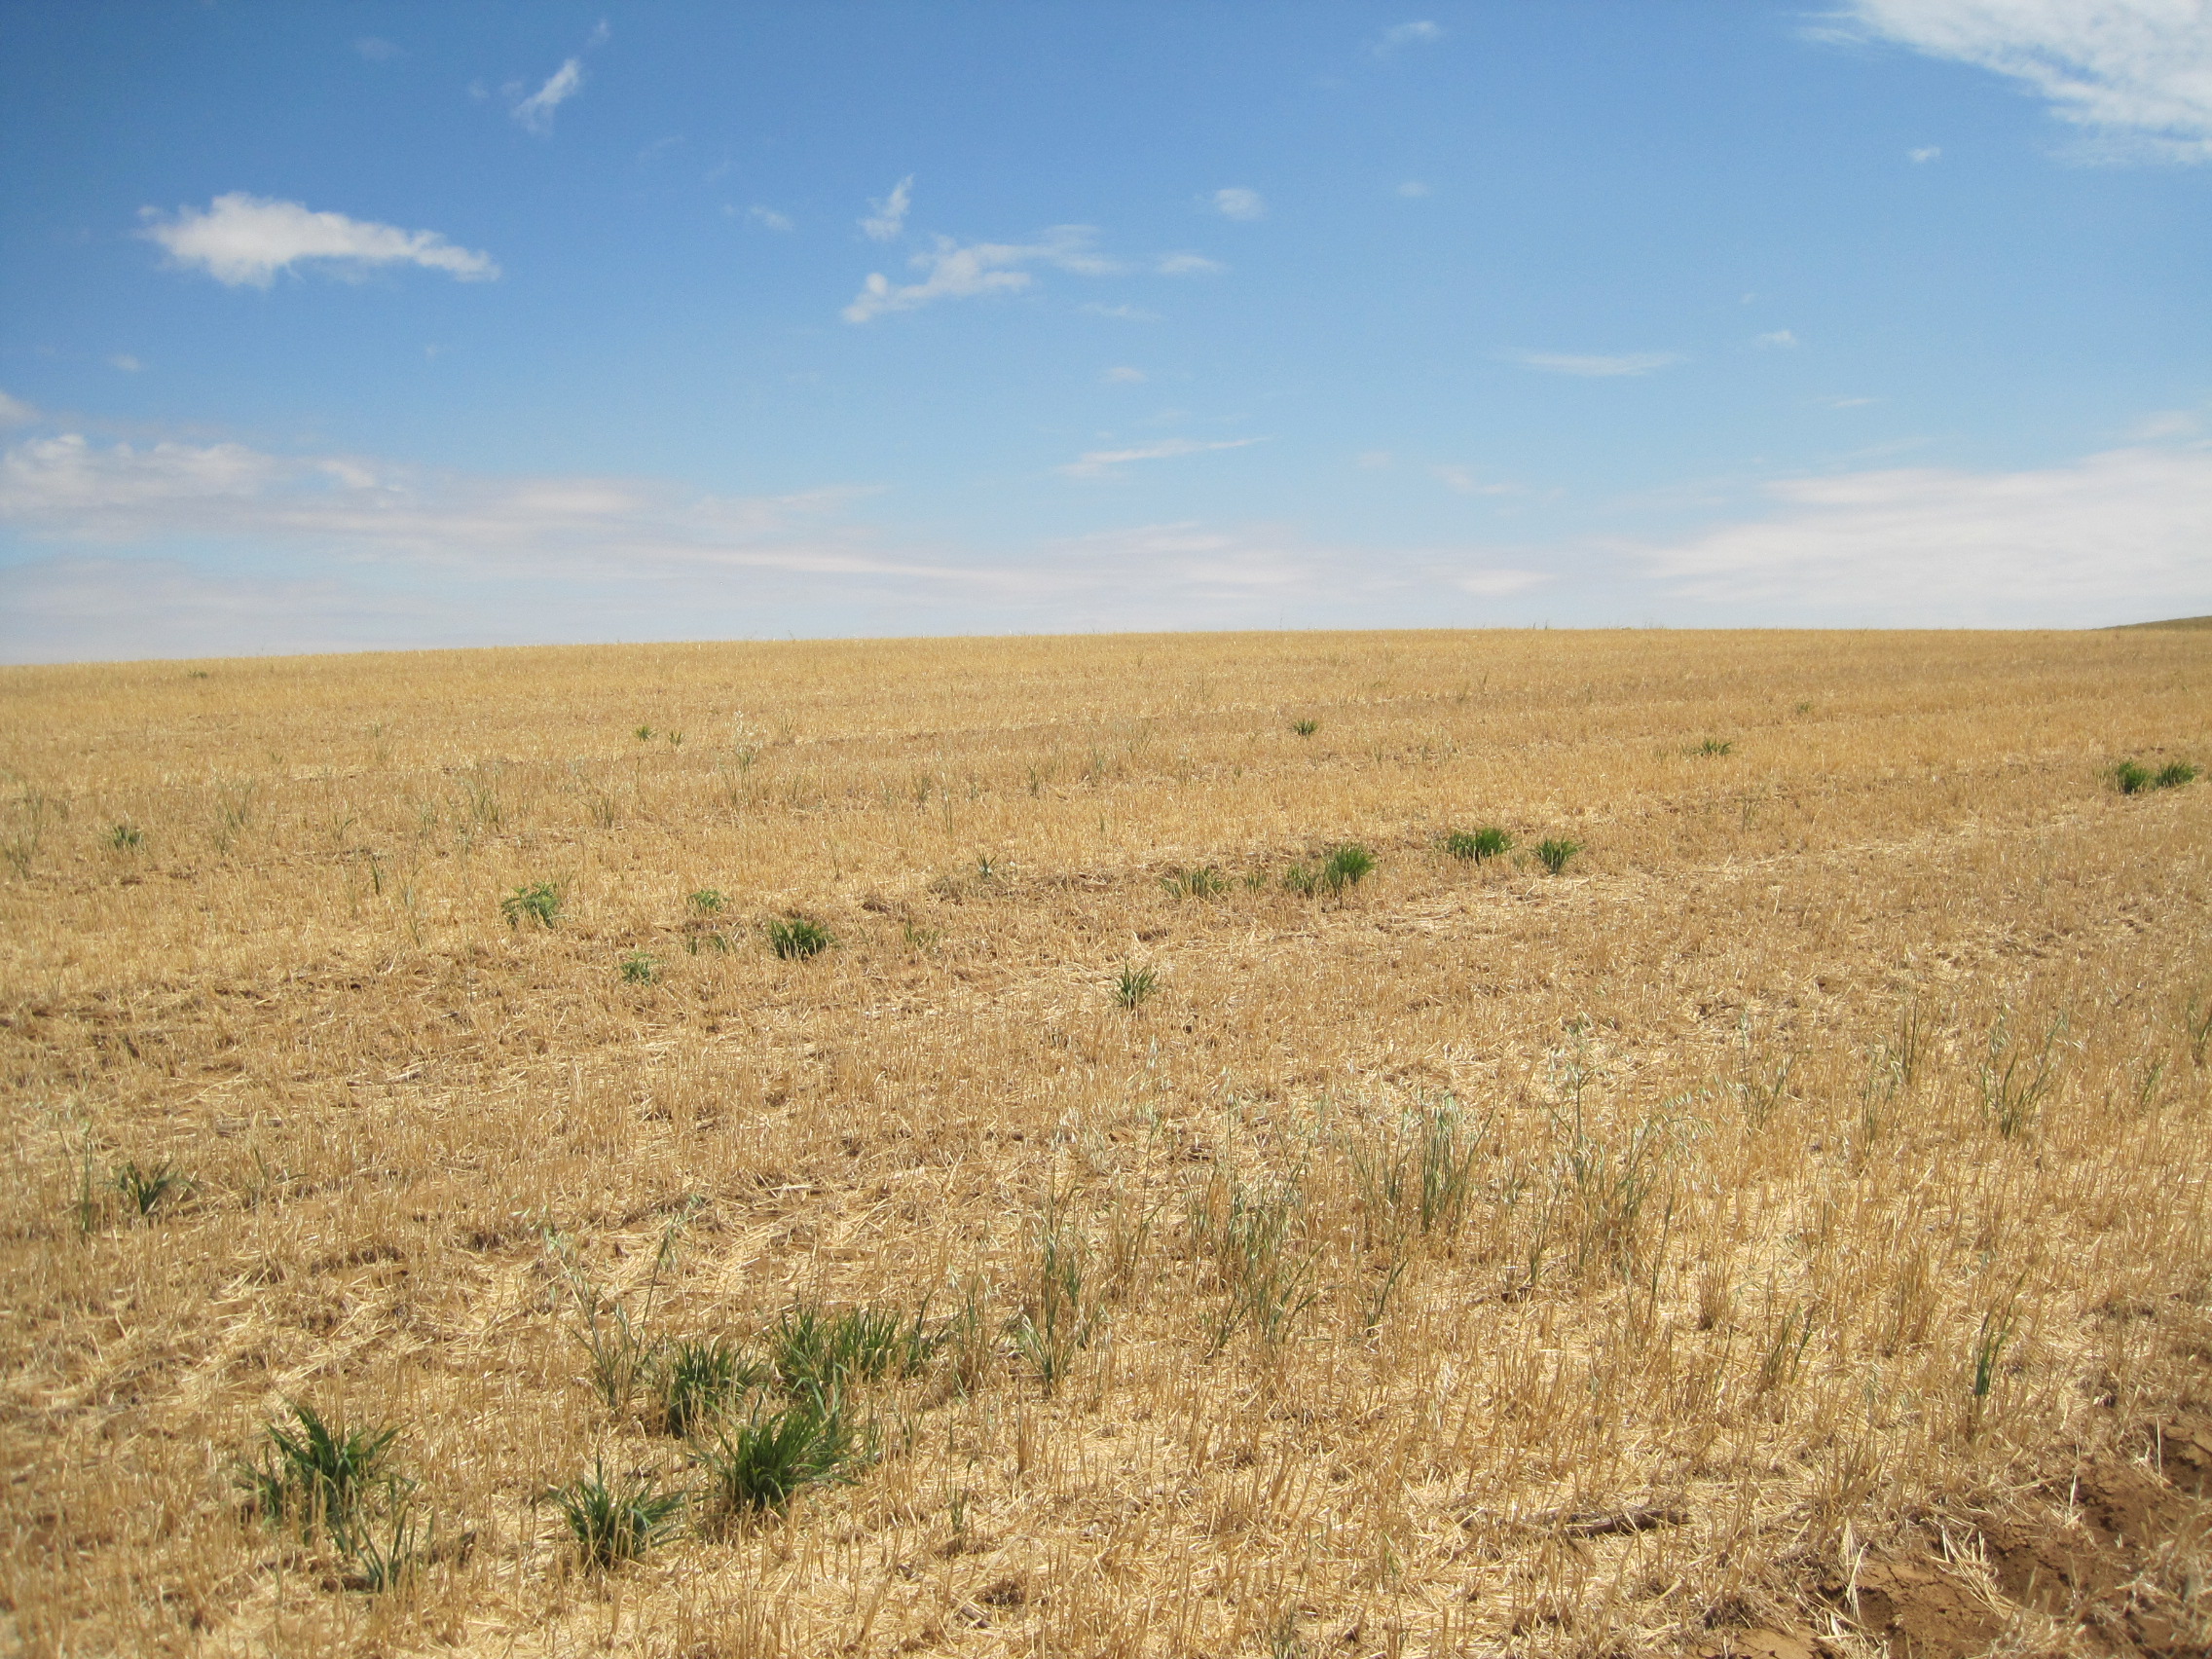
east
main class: Cropland
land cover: Barley
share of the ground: < 10 %
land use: Agriculture (excluding fallow land and kitchen gardens)
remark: Harvested field
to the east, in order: Barley; Grass margins; Common wheat; Grass margins; Other bare soil
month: July
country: ES
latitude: 42.0498
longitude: -5.1977
